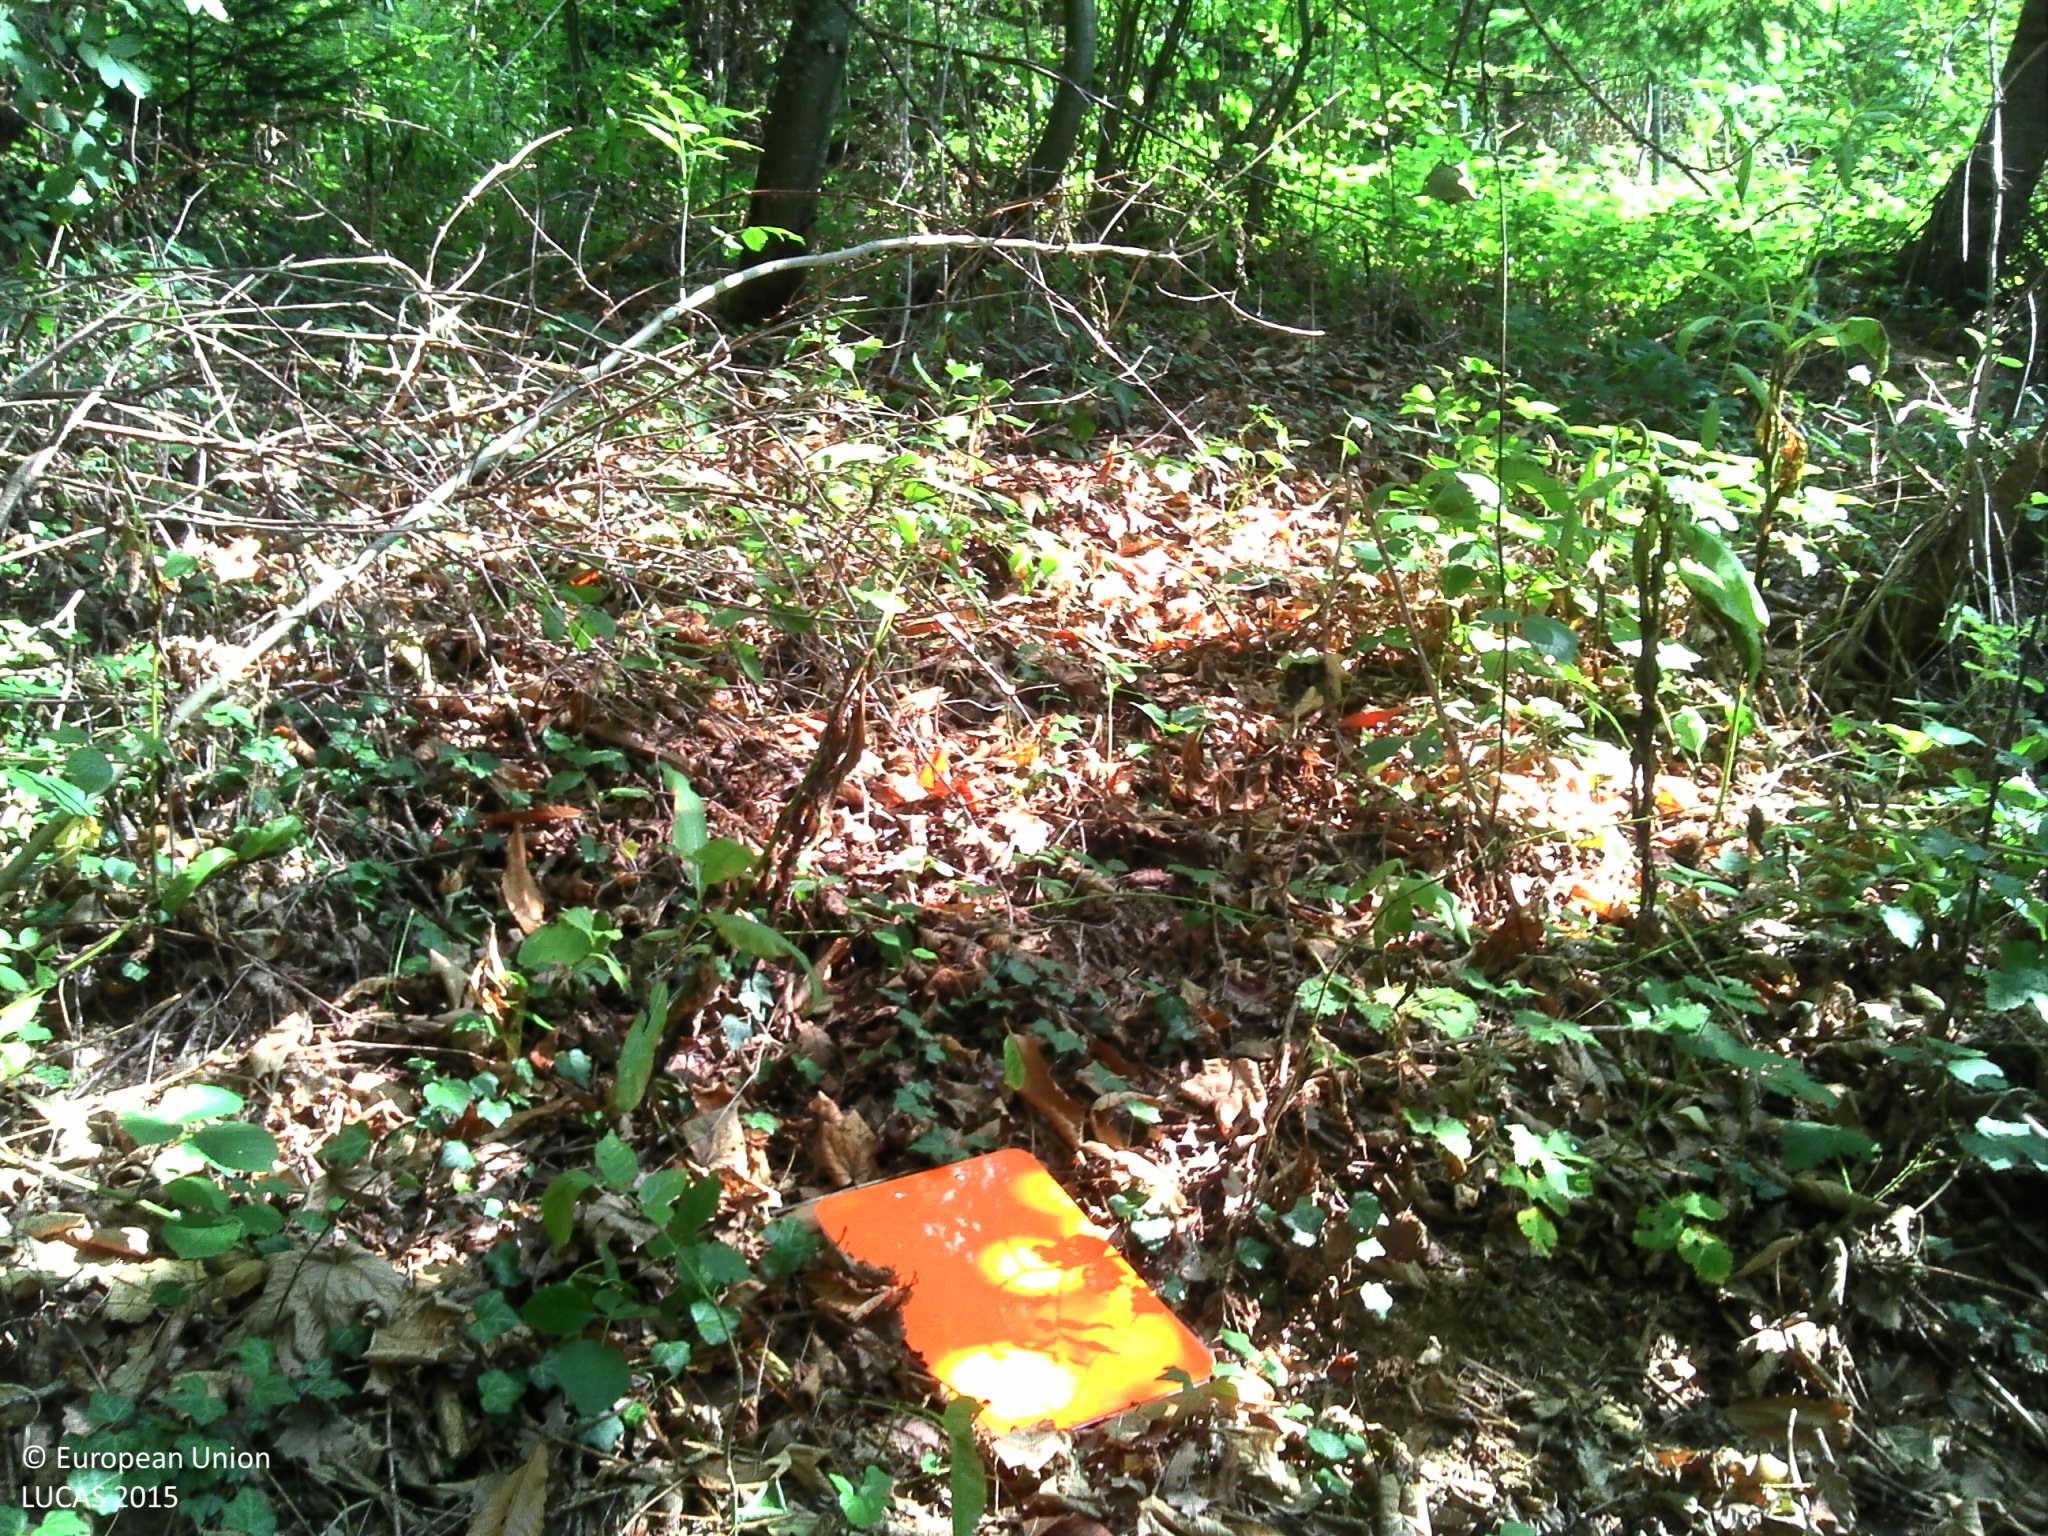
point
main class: Woodland
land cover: Spruce dominated mixed woodland
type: hemiboreal forest and nemoral coniferous forest and mixed broadleaved-coniferous forest
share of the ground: > 75 %
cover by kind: broadleaved forest trees 60 %, coniferous forest trees 20 %, herbaceous plants 20 %
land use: Semi-natural and natural areas not in use
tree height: < 5 m
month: August
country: FR
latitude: 46.1568
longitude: 4.5247
